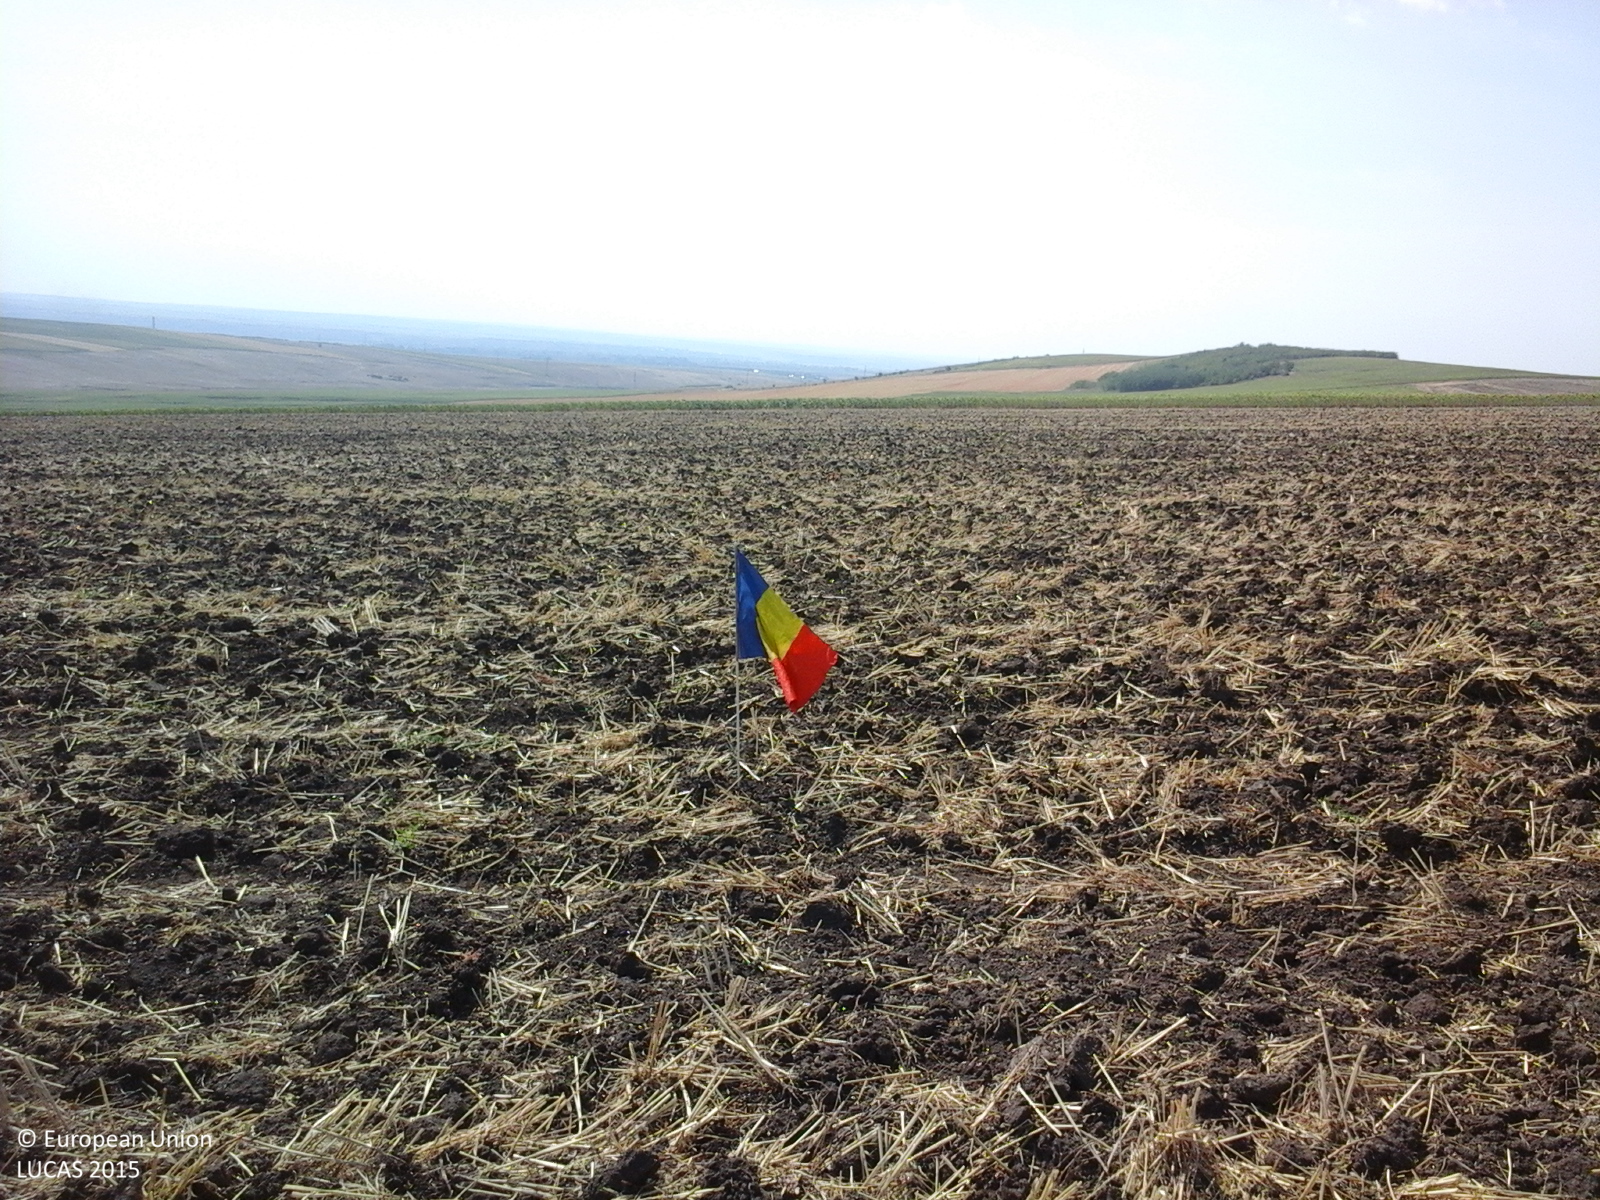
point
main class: Cropland
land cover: Common wheat
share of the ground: 10 - 25 %
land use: Agriculture (excluding fallow land and kitchen gardens)
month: July
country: RO
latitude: 46.3051
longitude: 28.0844
